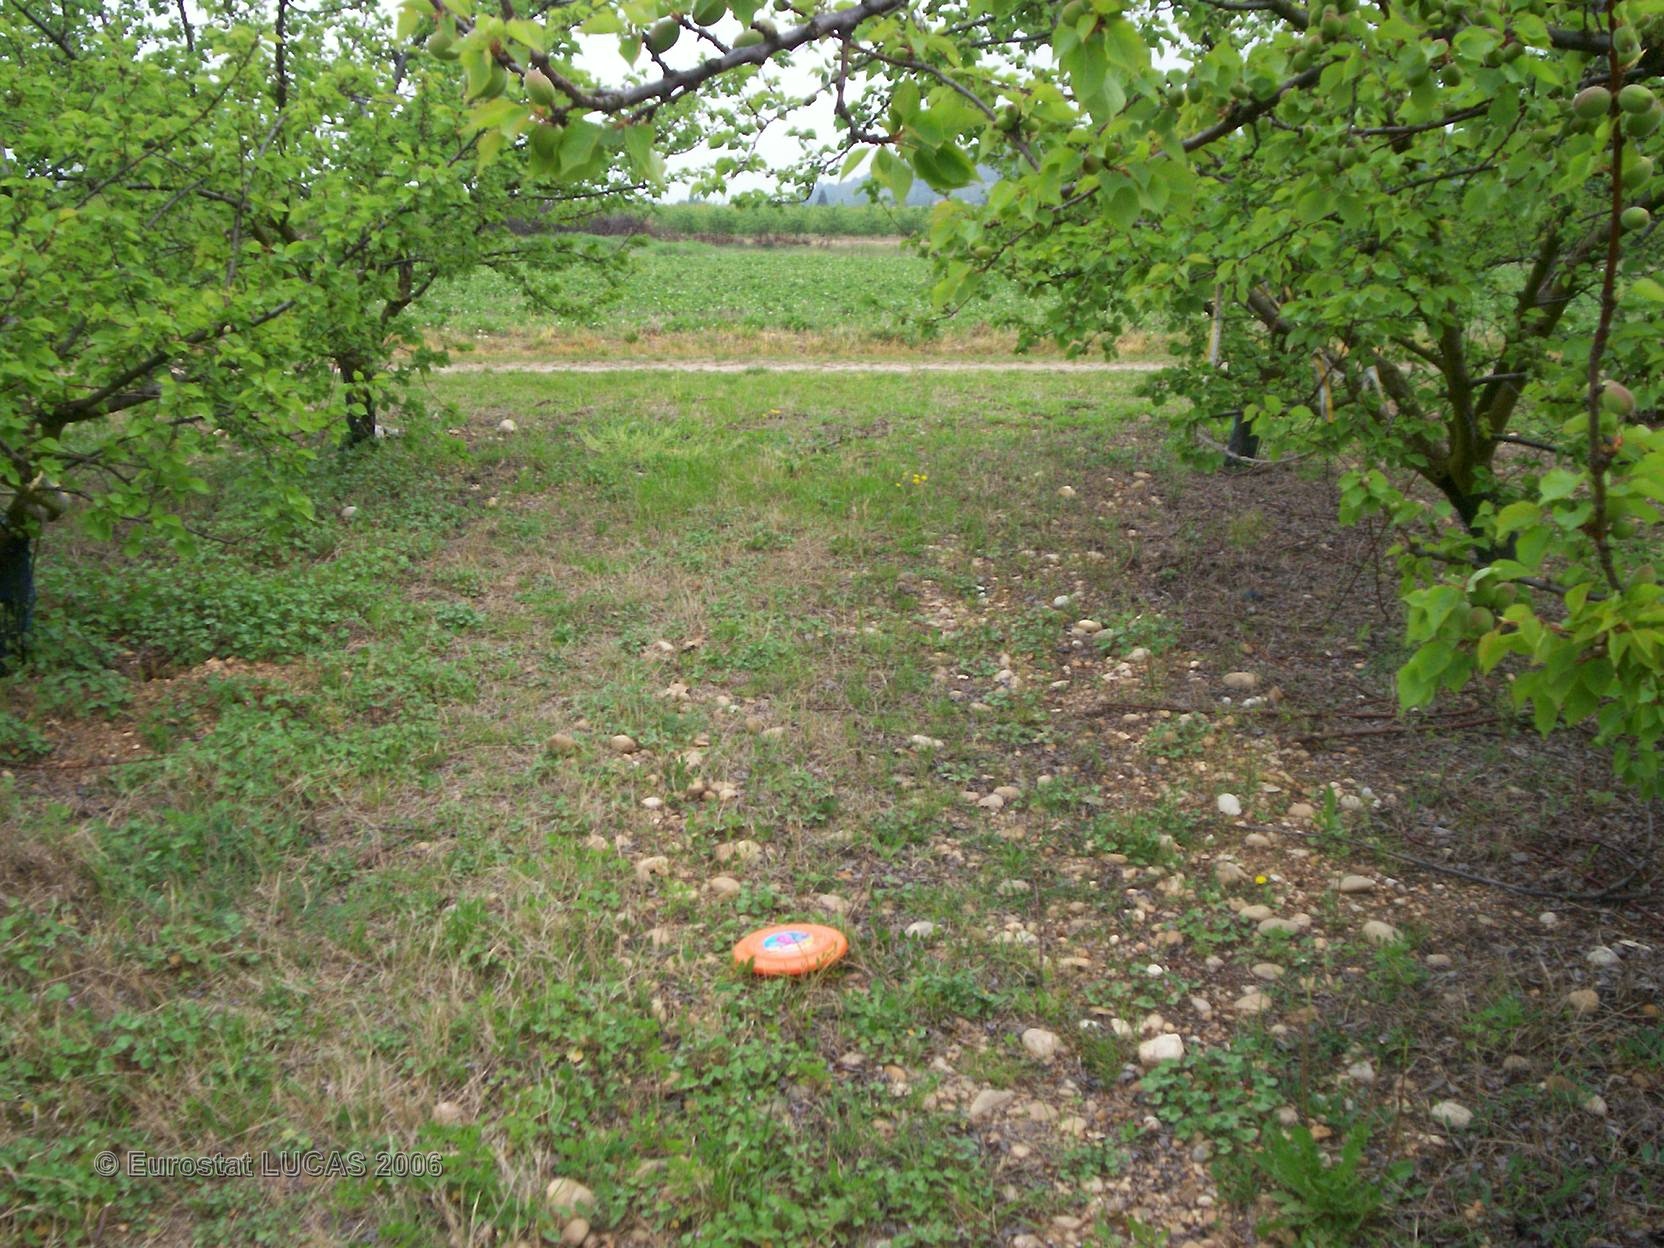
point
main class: Cropland
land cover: Other fruit trees and berries
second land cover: Grassland with sparse tree/shrub cover
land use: Agriculture (excluding fallow land and kitchen gardens)
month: April
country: FR
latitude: 45.3754
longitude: 4.7817
